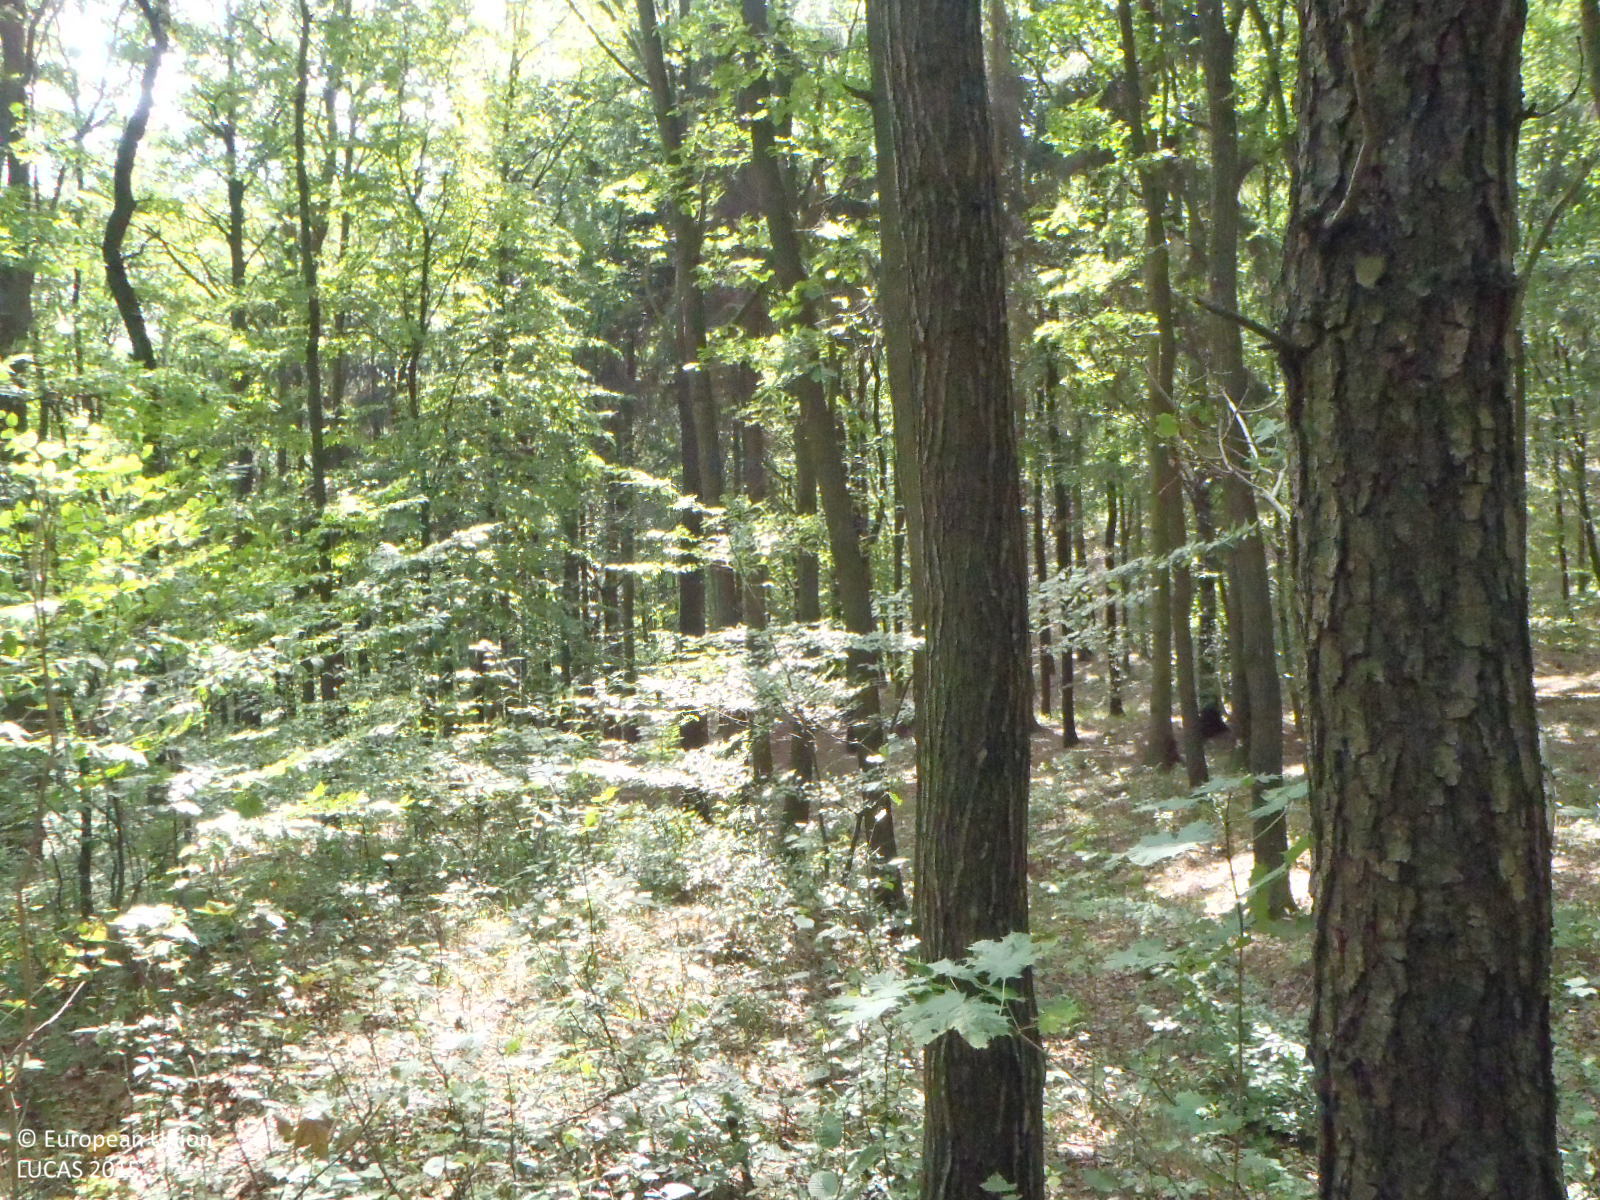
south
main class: Woodland
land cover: Spruce dominated mixed woodland
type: hemiboreal forest and nemoral coniferous forest and mixed broadleaved-coniferous forest
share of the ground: > 75 %
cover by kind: broadleaved forest trees 70 %, coniferous forest trees 30 %
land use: Forestry
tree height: > 5 m
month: September
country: CZ
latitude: 50.6938
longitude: 13.8939
